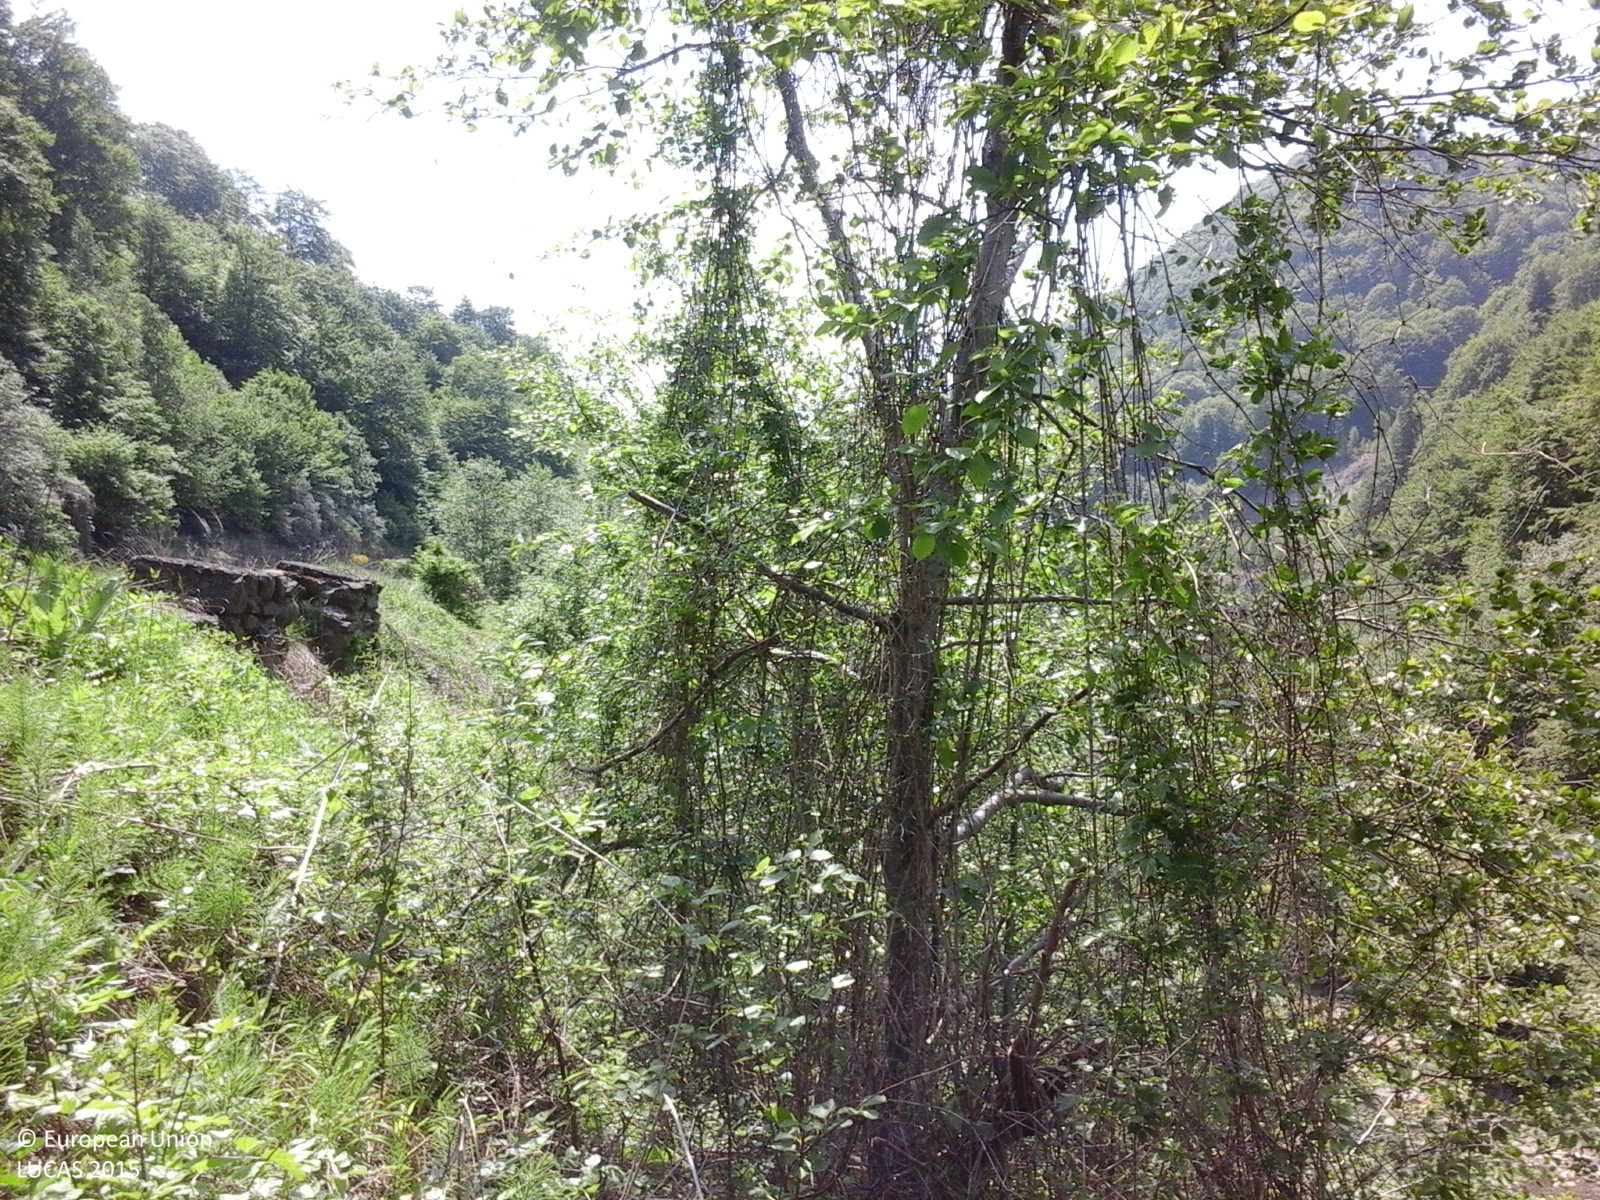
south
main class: Woodland
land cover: Broadleaved woodland
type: non-riverine alder, birch or aspen forest
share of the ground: > 75 %
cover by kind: broadleaved forest trees 75 %, shrubs 15 %, herbaceous plants 10 %
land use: Semi-natural and natural areas not in use
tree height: > 5 m
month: May
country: RO
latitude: 45.5475
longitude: 26.1926
